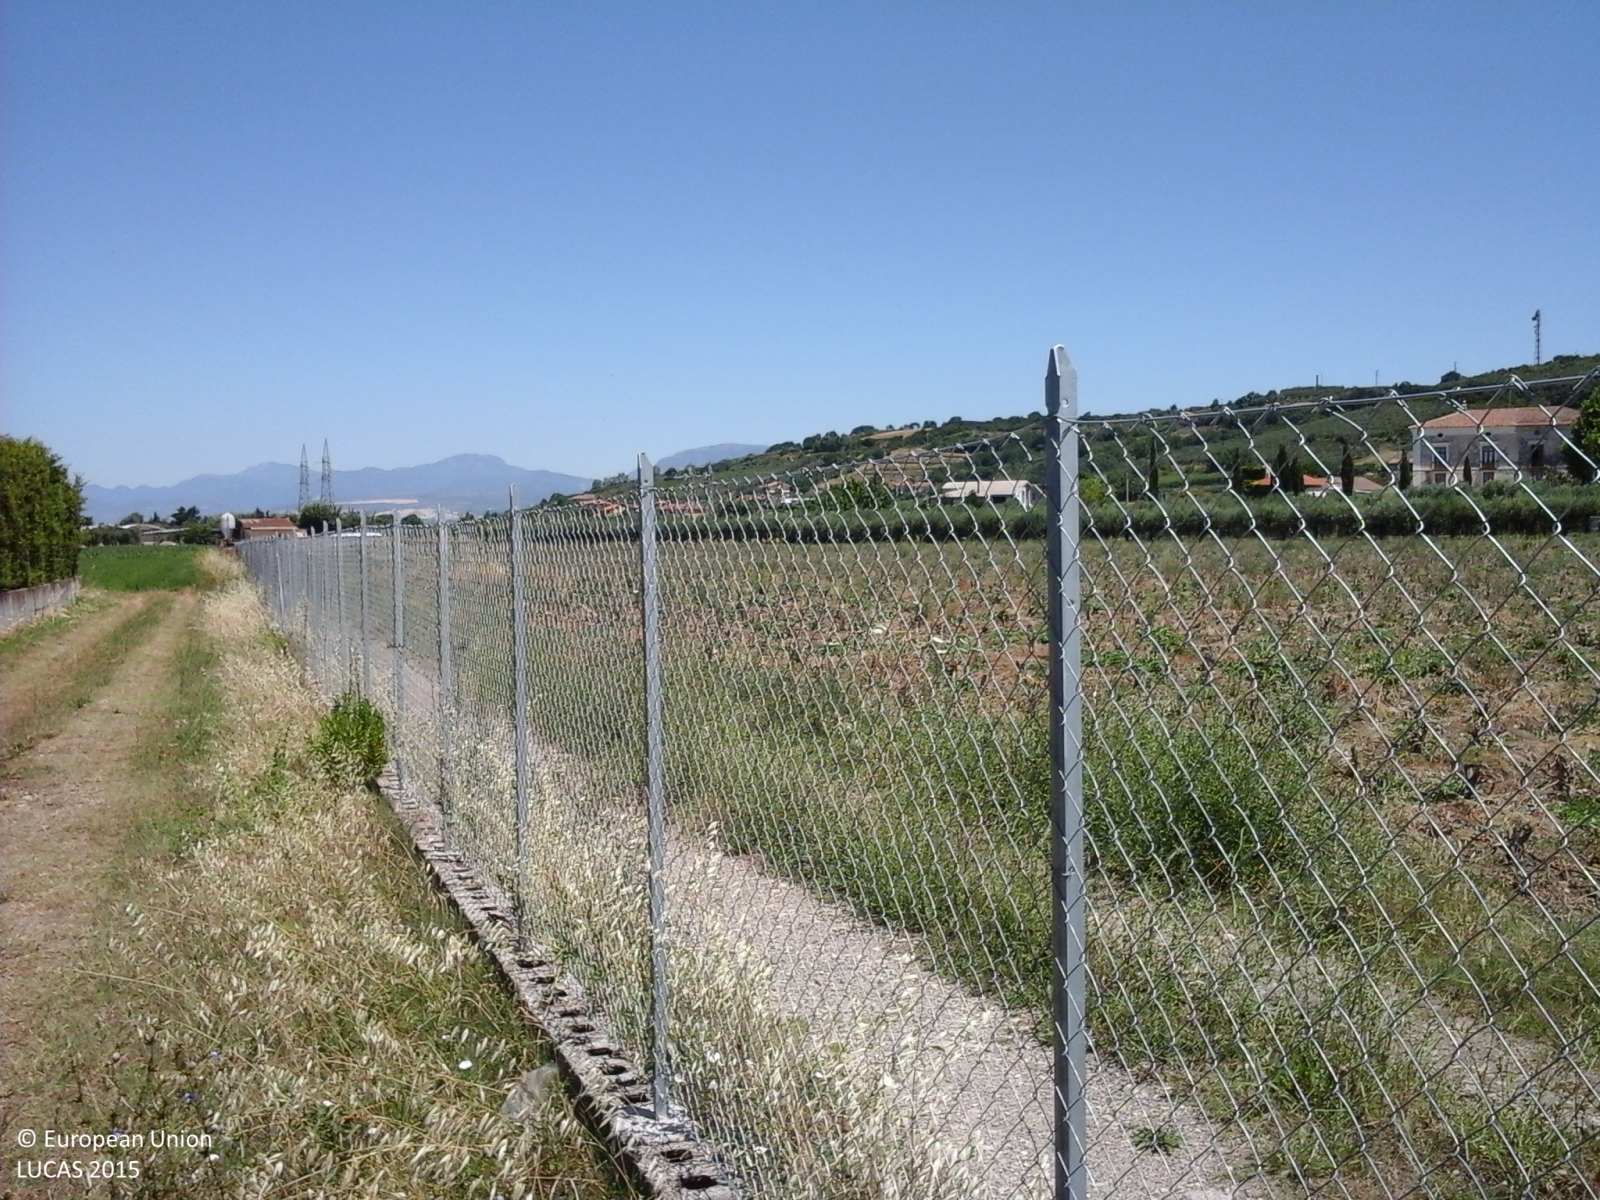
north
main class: Cropland
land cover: Other fresh vegetables
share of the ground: 50 - 75 %
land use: Agriculture (excluding fallow land and kitchen gardens)
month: June
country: IT
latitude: 40.4642
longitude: 15.0379
